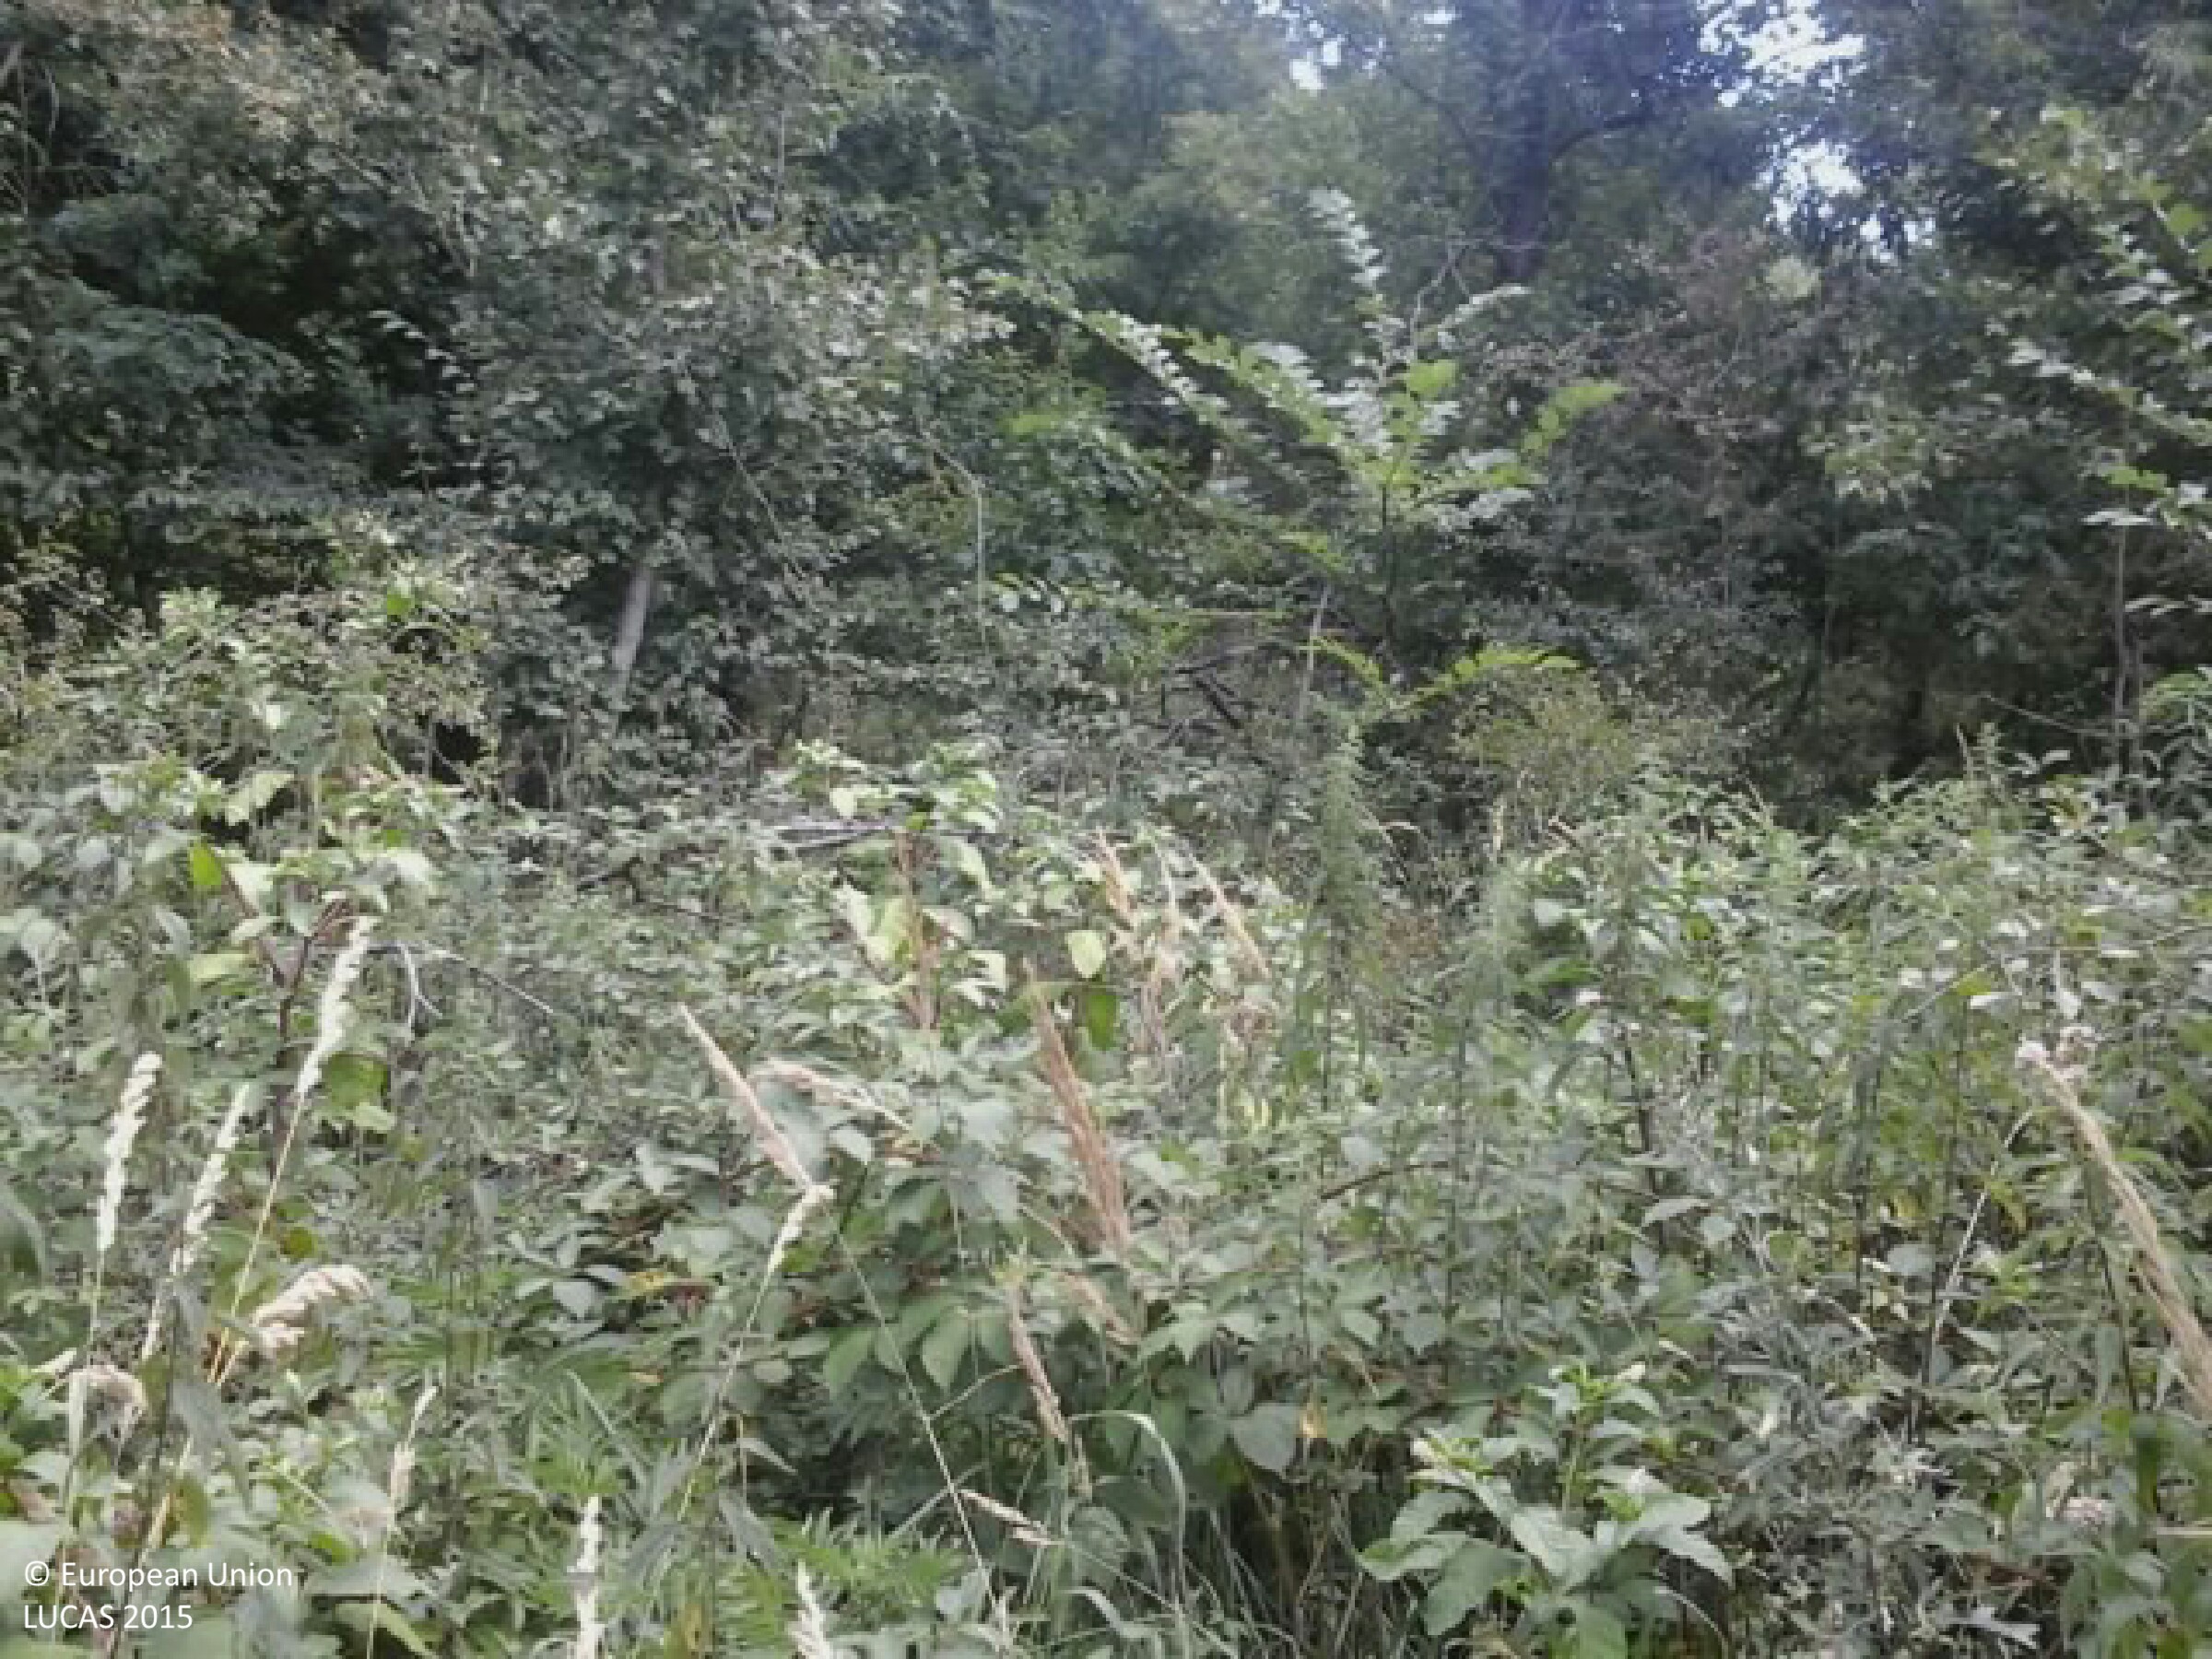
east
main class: Woodland
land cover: Broadleaved woodland
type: mesophytic deciduous forest
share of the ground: > 75 %
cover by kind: broadleaved forest trees 95 %, herbaceous plants 5 %
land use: Forestry
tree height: > 5 m
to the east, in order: Broadleaved woodland; Tracks; Broadleaved woodland; Grassland without tree/shrub cover; Broadleaved woodland
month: August
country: HU
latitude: 46.1742
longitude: 18.2849
